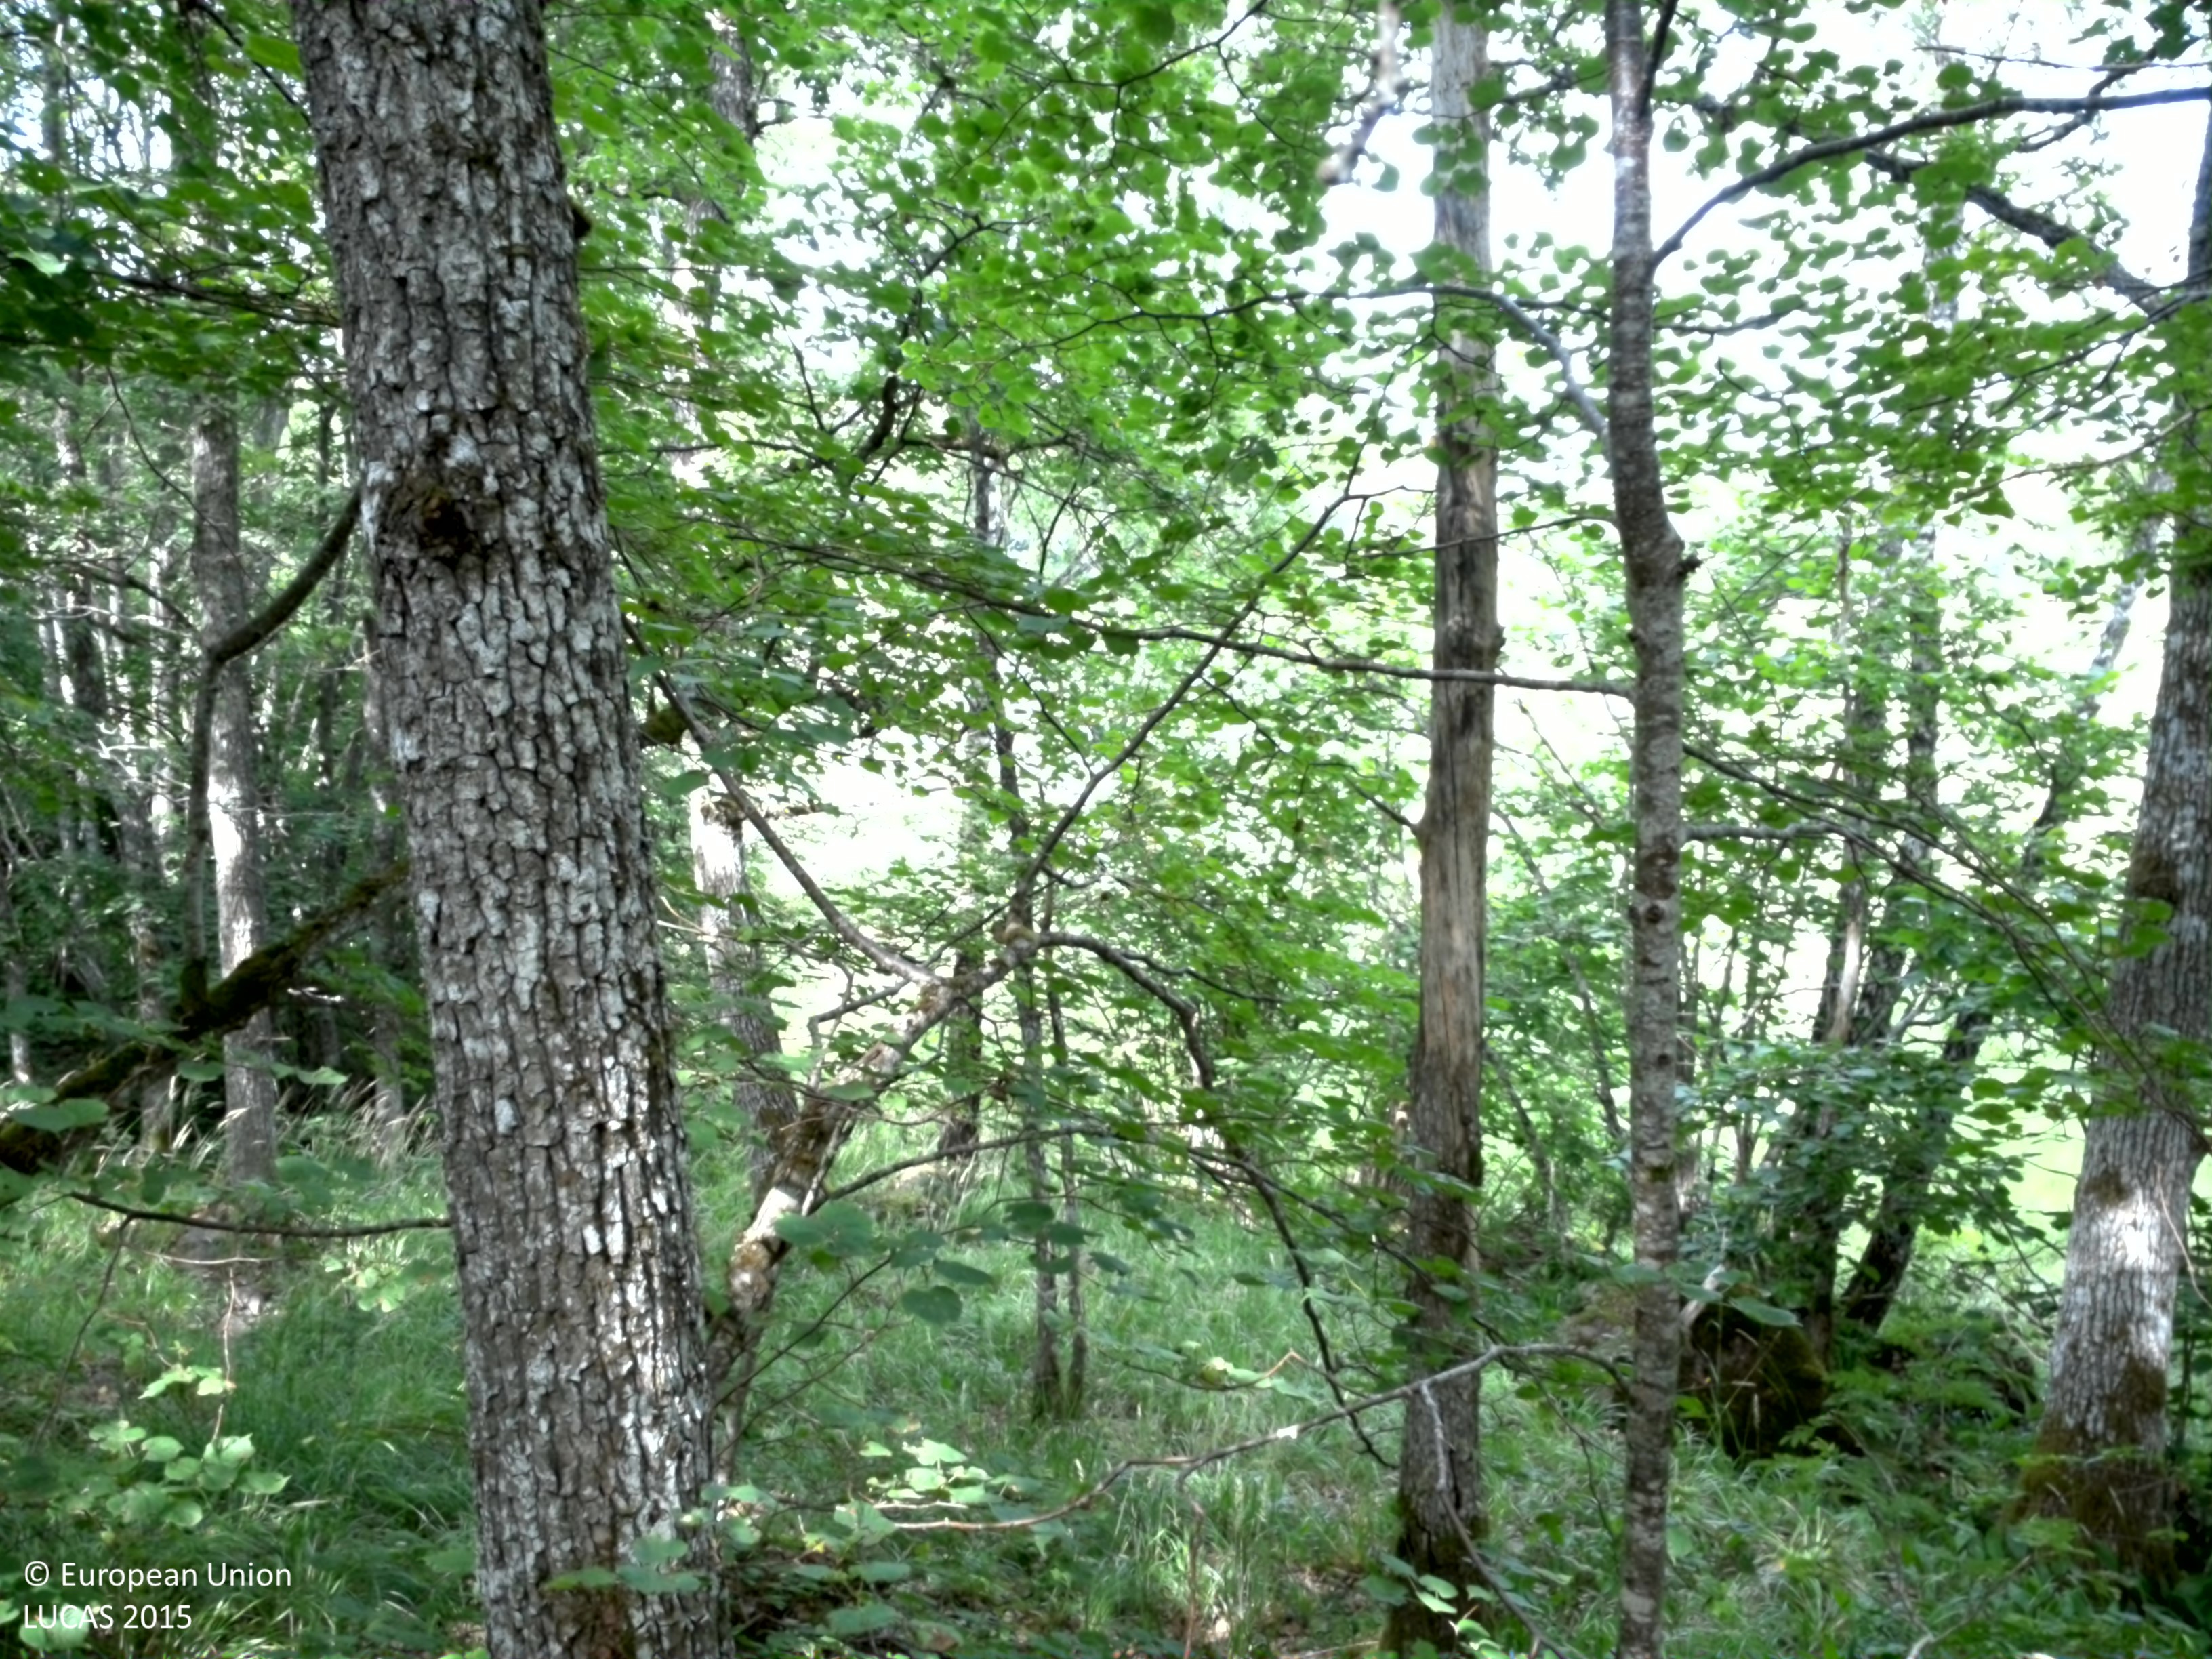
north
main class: Woodland
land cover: Broadleaved woodland
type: hemiboreal forest and nemoral coniferous forest and mixed broadleaved-coniferous forest
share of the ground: > 75 %
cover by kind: broadleaved forest trees 80 %, herbaceous plants 15 %, shrubs 5 %
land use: Forestry
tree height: > 5 m
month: August
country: SE
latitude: 59.8820
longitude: 17.9820
